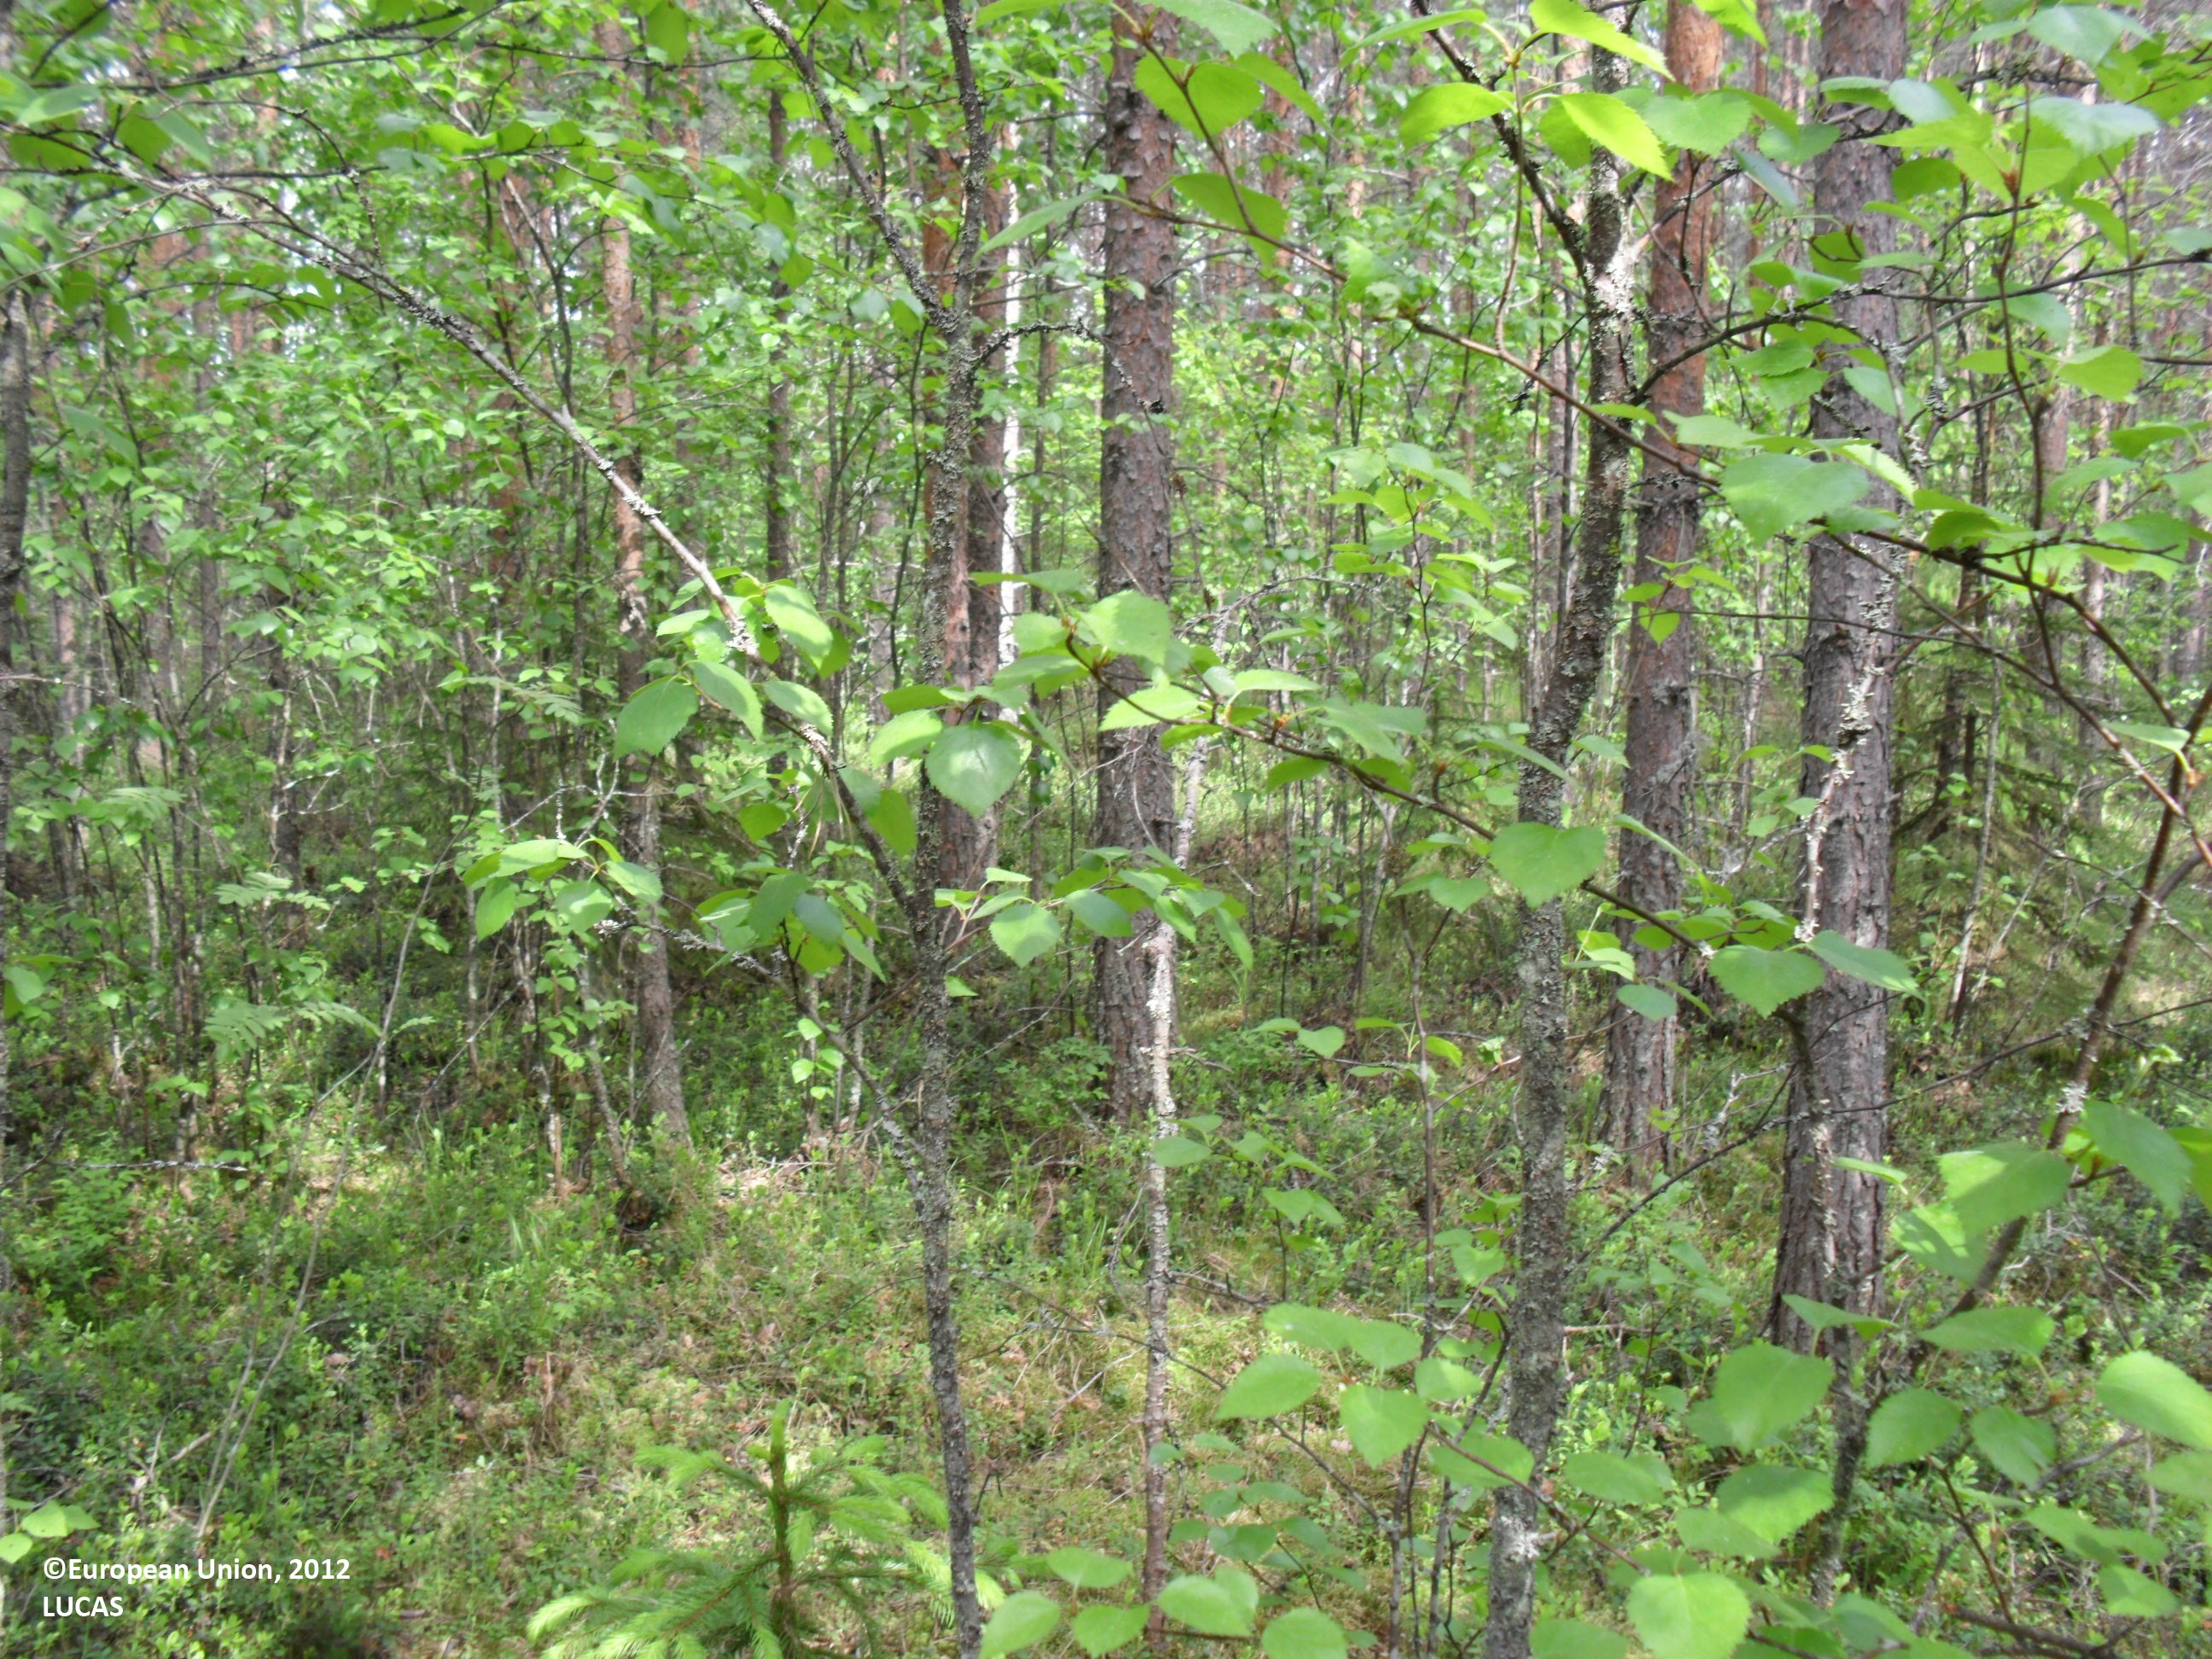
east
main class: Woodland
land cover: Pine dominated mixed woodland
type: boreal forest
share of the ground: 50 - 75 %
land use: Forestry
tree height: > 5 m
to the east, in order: Pine dominated mixed woodland; Ditches and canals; Temporary grasslands; Ditches and canals; Other mixed woodland; Other coniferous woodland
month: June
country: FI
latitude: 62.8850
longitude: 23.4598
